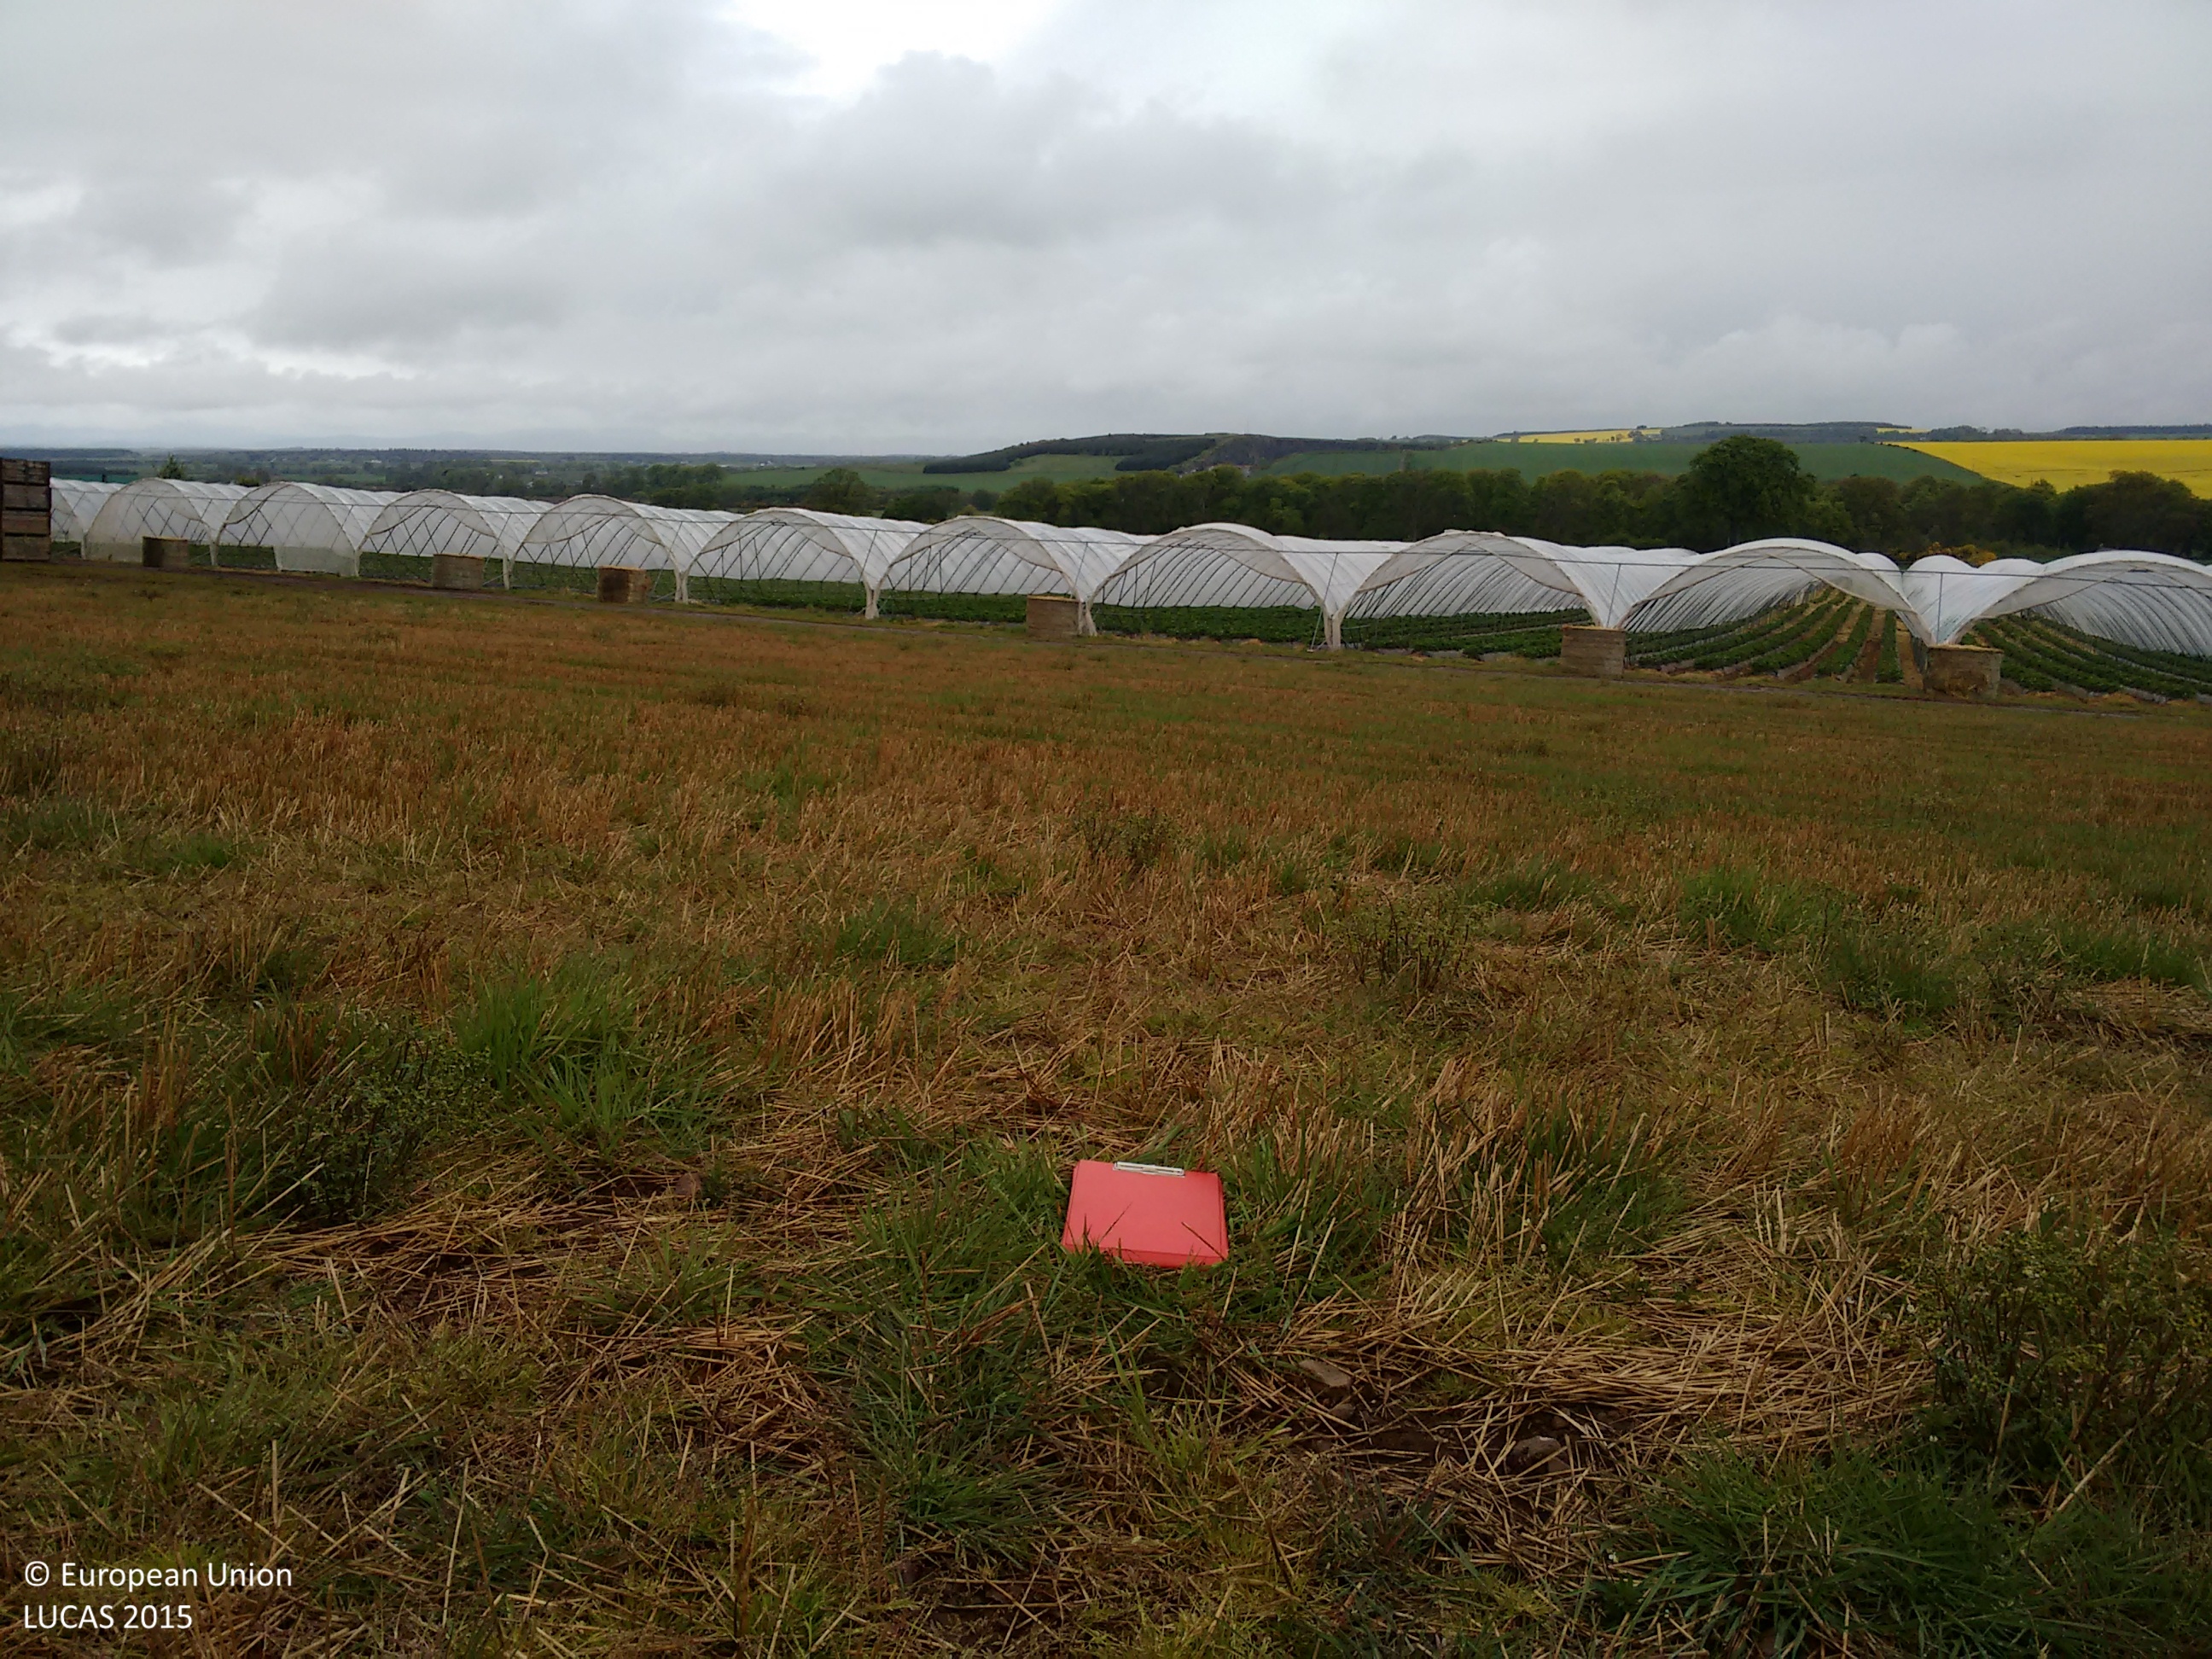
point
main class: Grassland
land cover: Grassland without tree/shrub cover
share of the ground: > 75 %
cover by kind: herbaceous plants 100 %
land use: Agriculture (excluding fallow land and kitchen gardens)
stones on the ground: 10 - 25 %
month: May
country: GB
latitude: 56.6215
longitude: -2.5910
